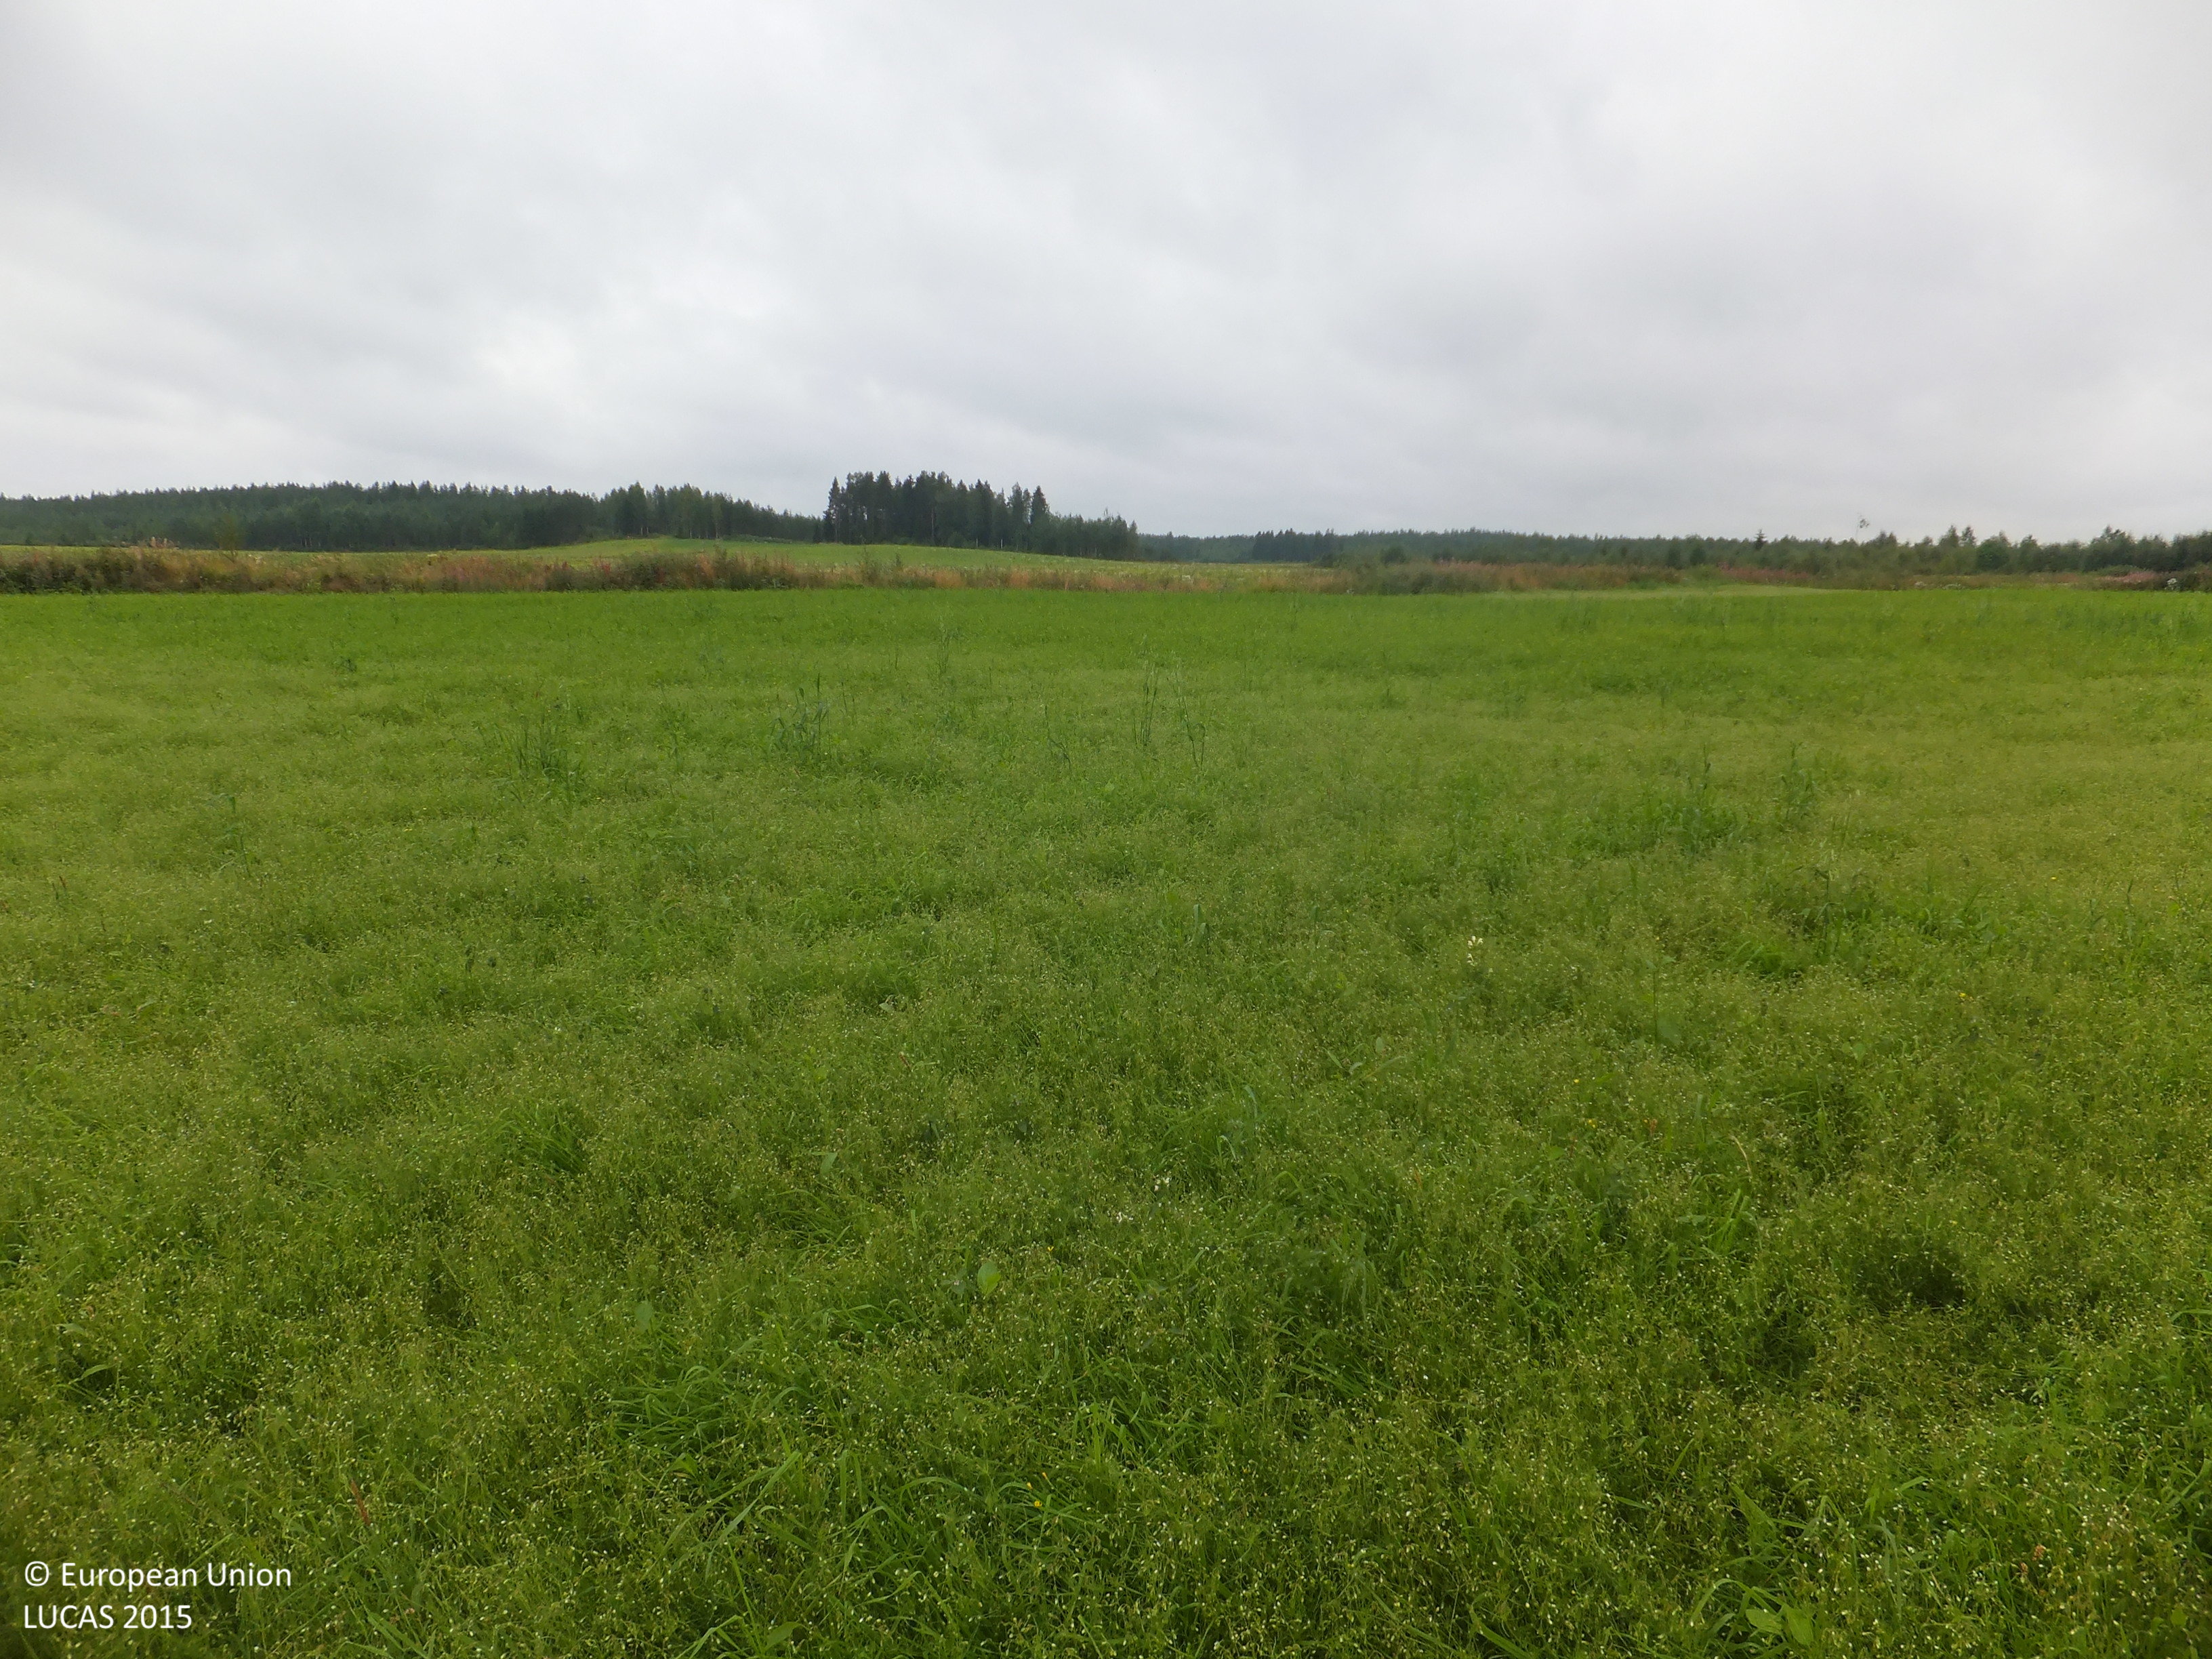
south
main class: Cropland
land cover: Temporary grasslands
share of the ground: > 75 %
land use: Agriculture (excluding fallow land and kitchen gardens)
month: August
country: FI
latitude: 63.3032
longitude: 23.0851
